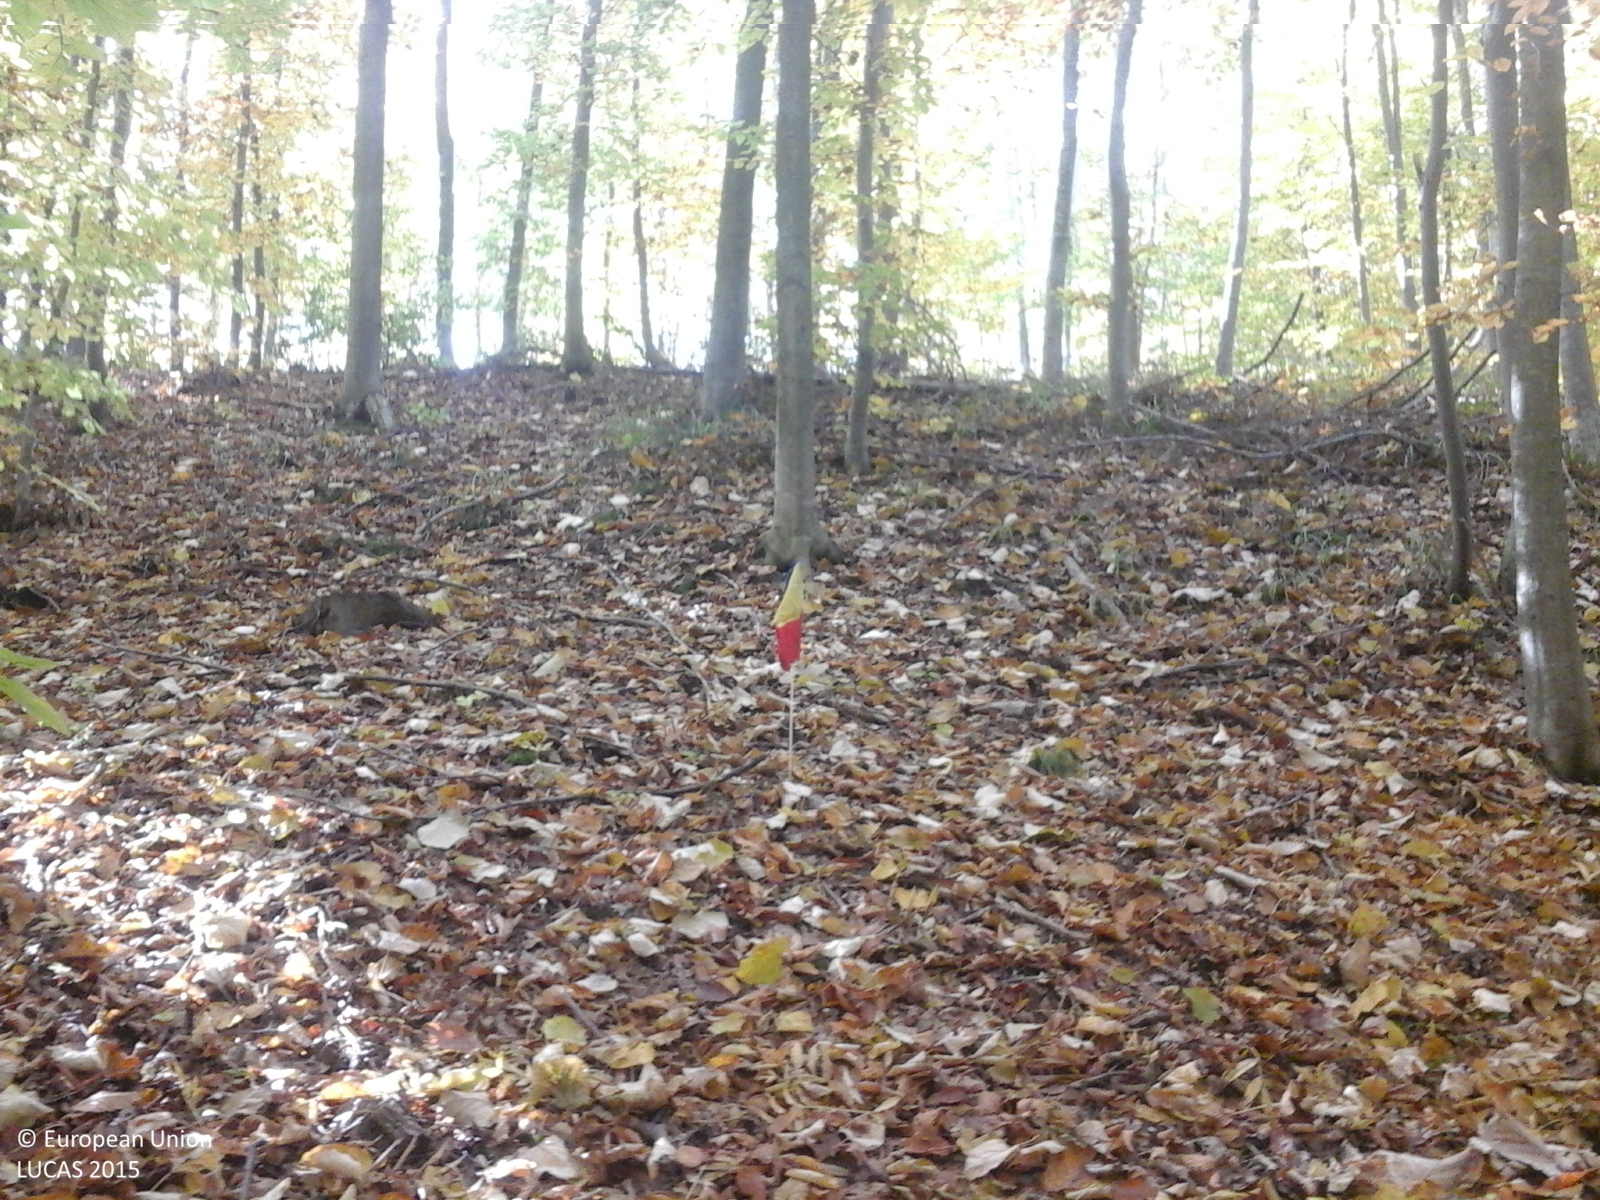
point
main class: Woodland
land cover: Broadleaved woodland
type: beech forest
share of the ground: > 75 %
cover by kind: broadleaved forest trees 100 %
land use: Forestry
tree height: > 5 m
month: October
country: RO
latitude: 45.1420
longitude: 26.4368
